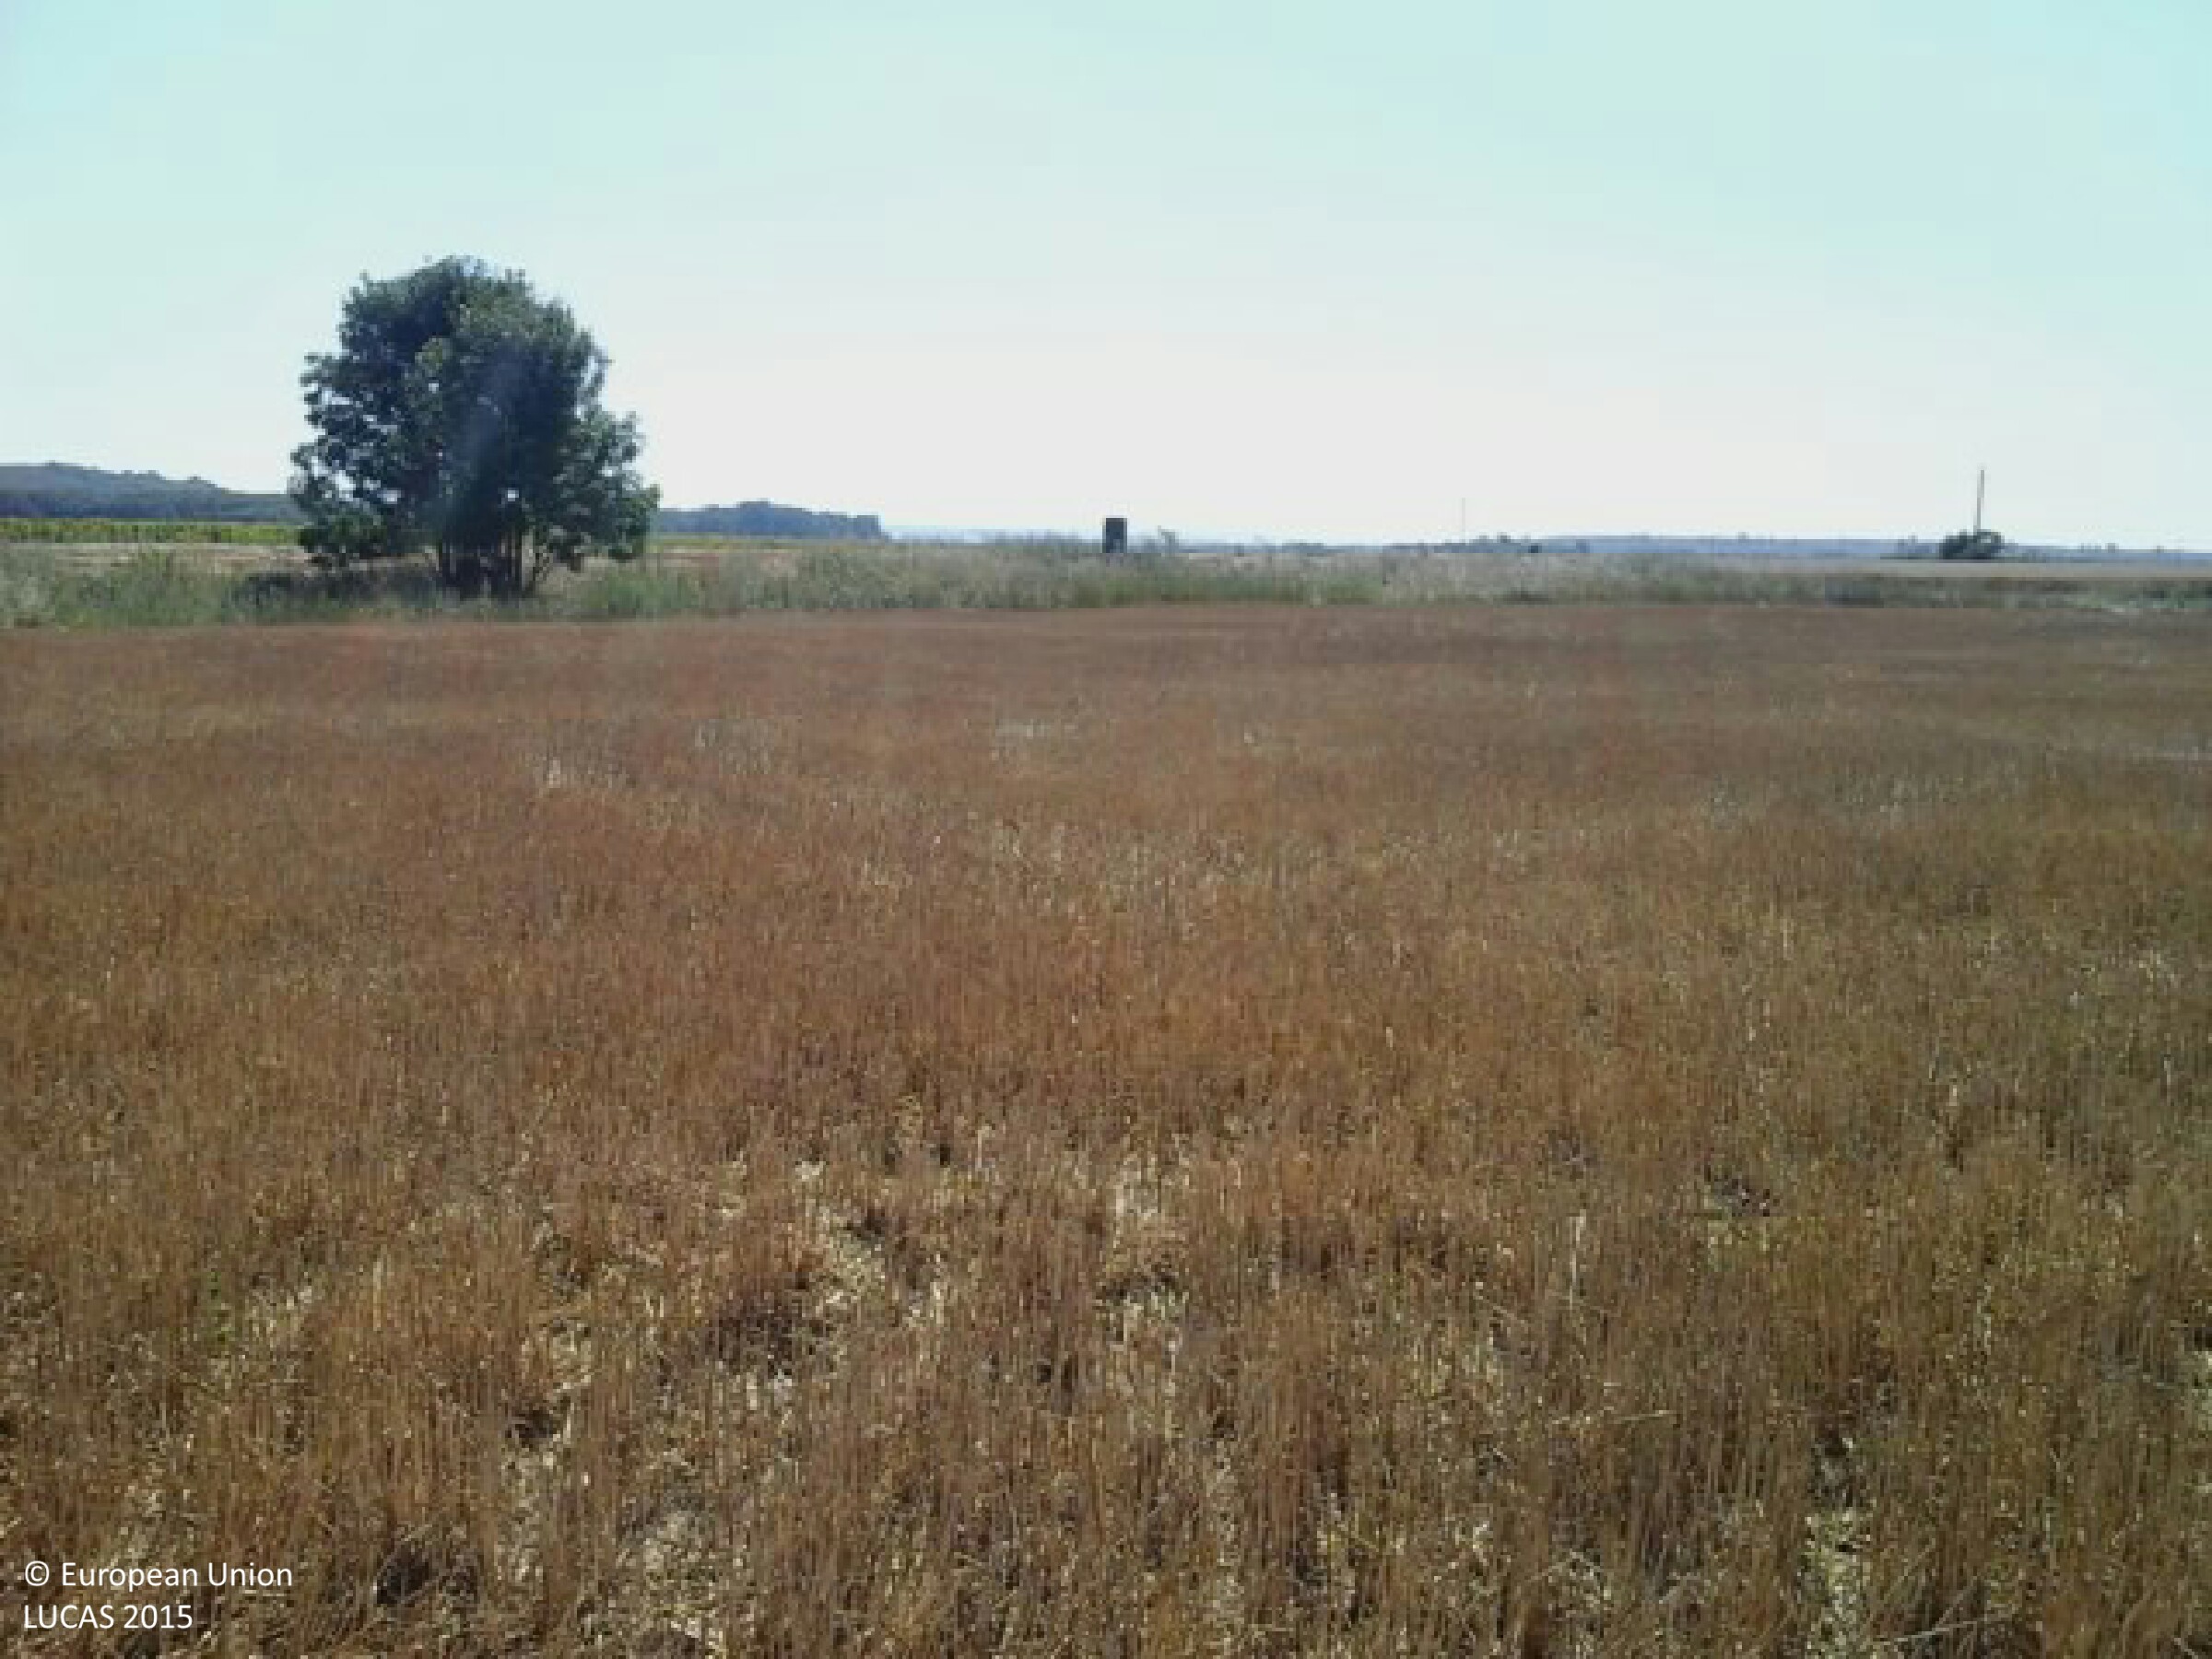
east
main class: Cropland
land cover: Common wheat
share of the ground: > 75 %
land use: Agriculture (excluding fallow land and kitchen gardens)
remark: Harvested field
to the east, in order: Common wheat; Grassland without tree/shrub cover; Ditches and canals; Grassland without tree/shrub cover; Common wheat; Sunflower
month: July
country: HU
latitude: 48.2672
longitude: 20.6655
